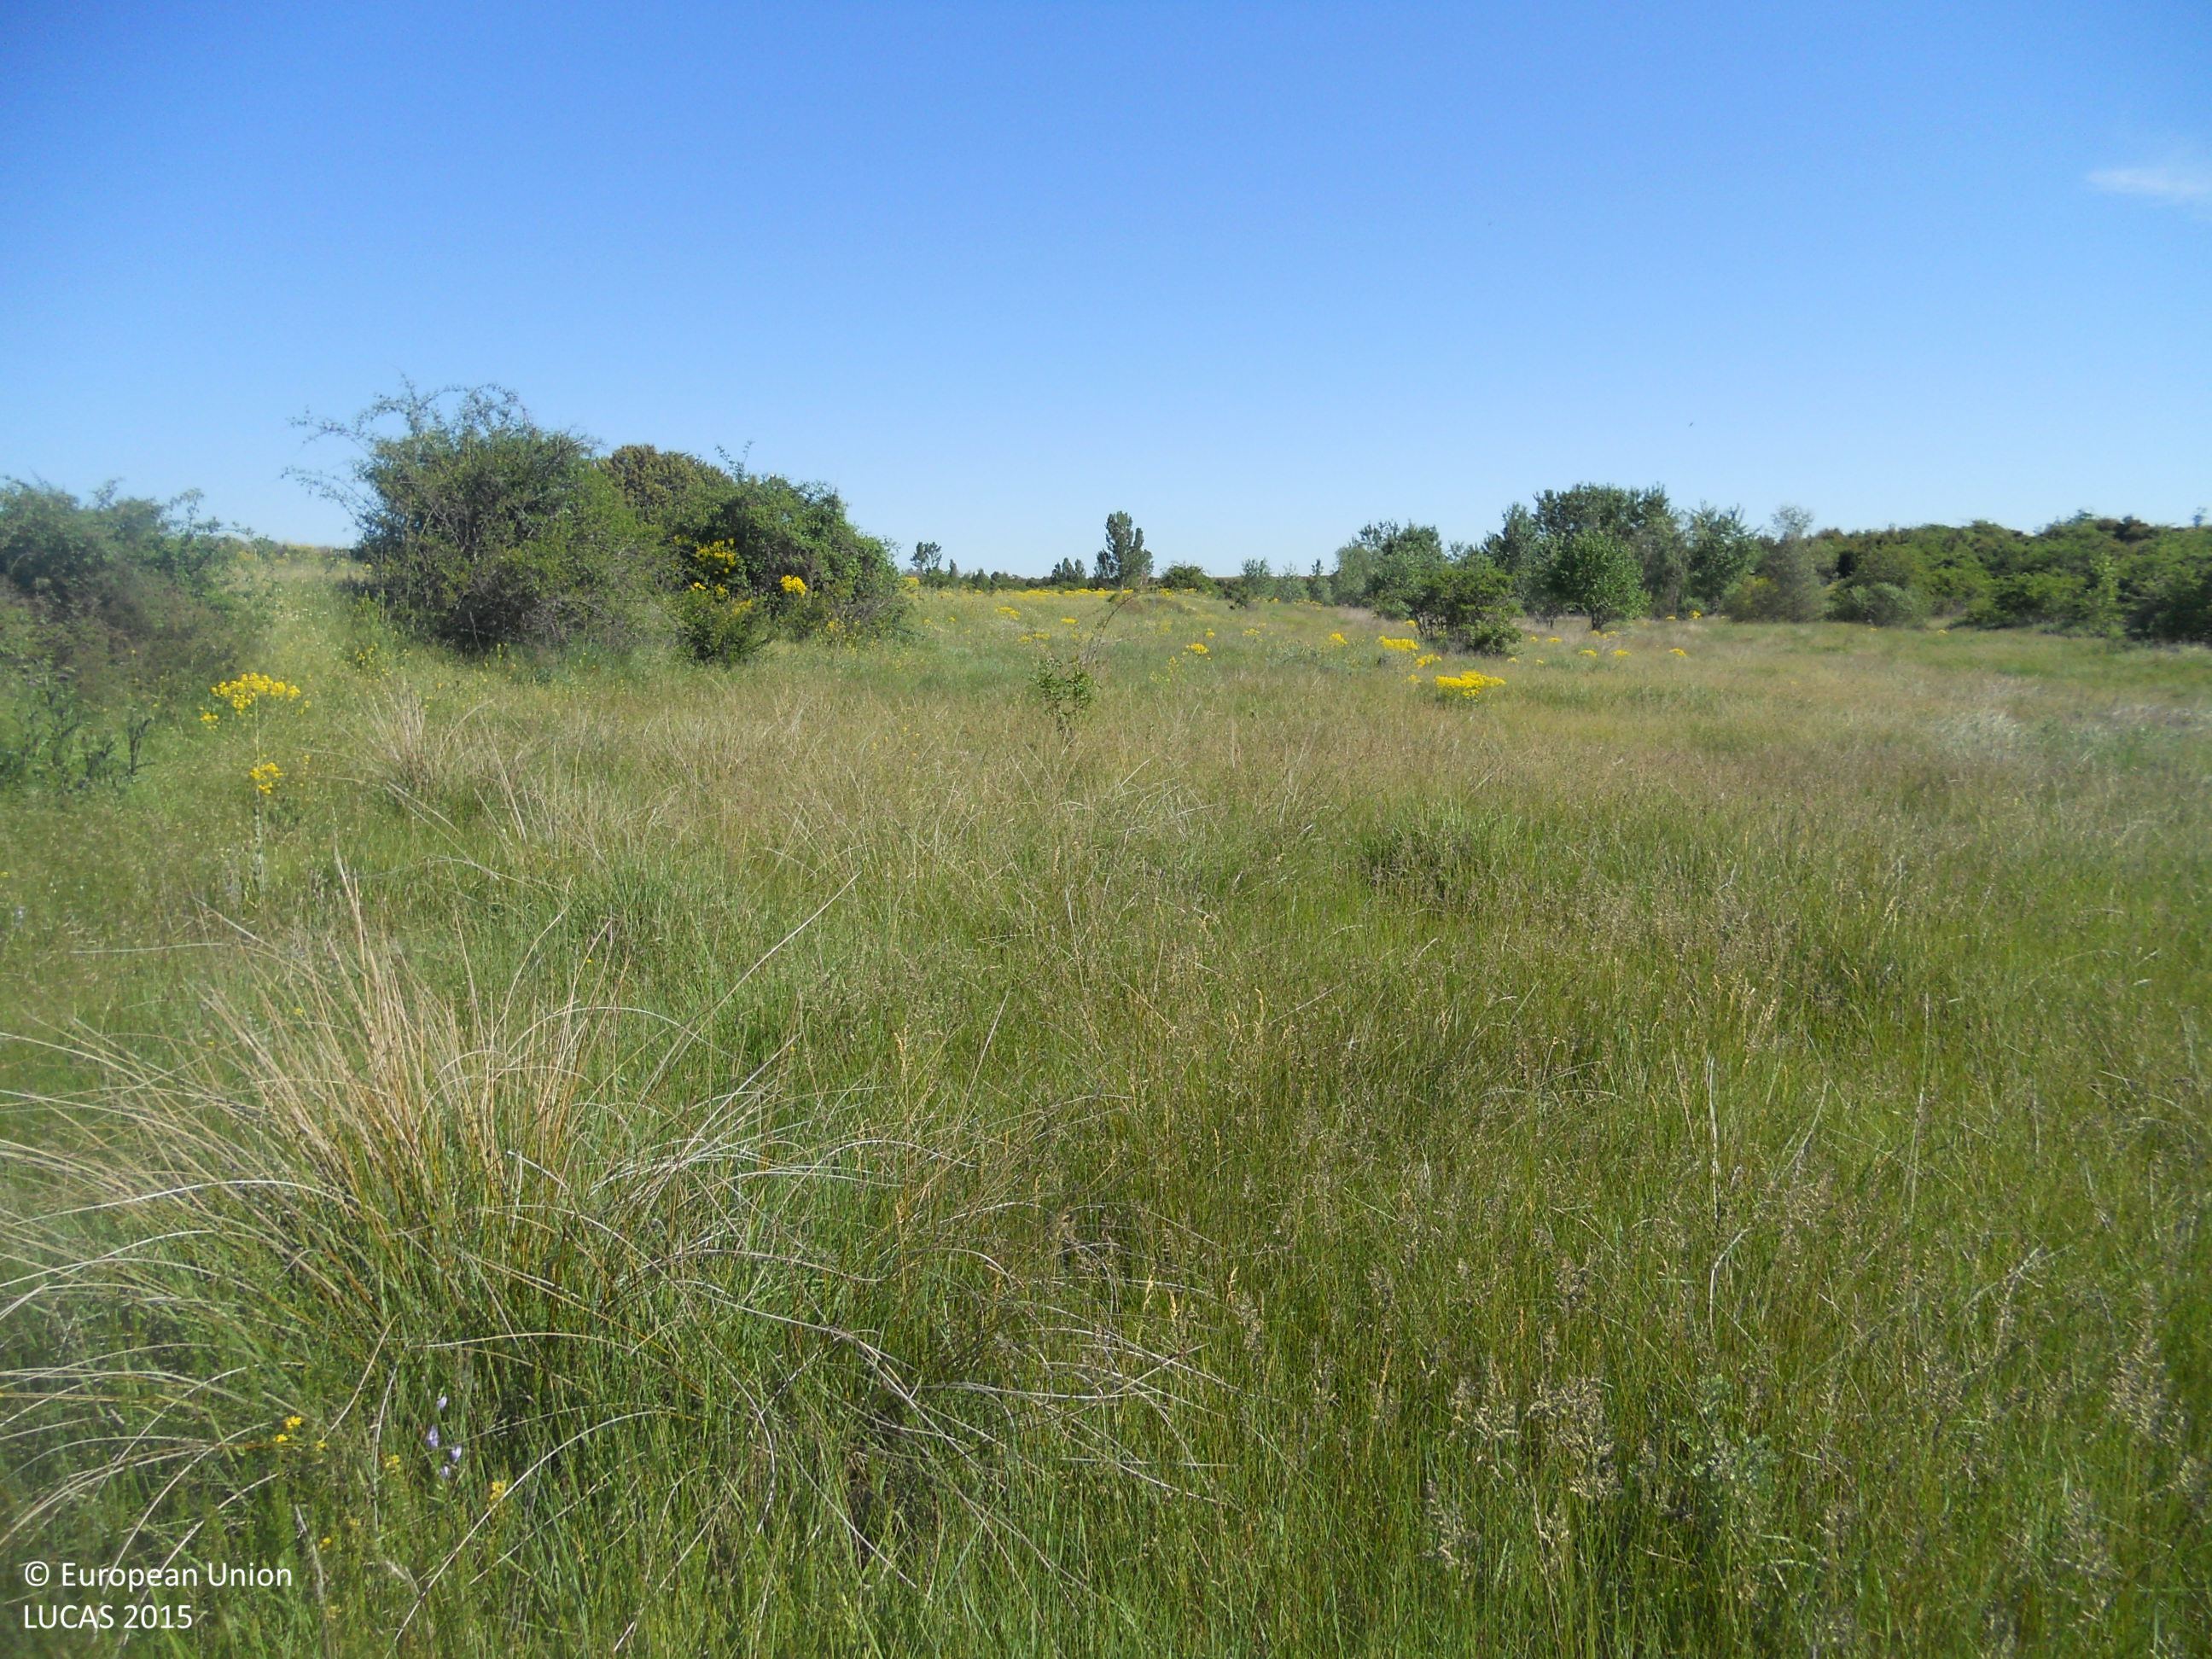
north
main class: Grassland
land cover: Grassland without tree/shrub cover
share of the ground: > 75 %
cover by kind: herbaceous plants 100 %
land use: Semi-natural and natural areas not in use
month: May
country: ES
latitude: 42.4504
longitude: -5.5737
